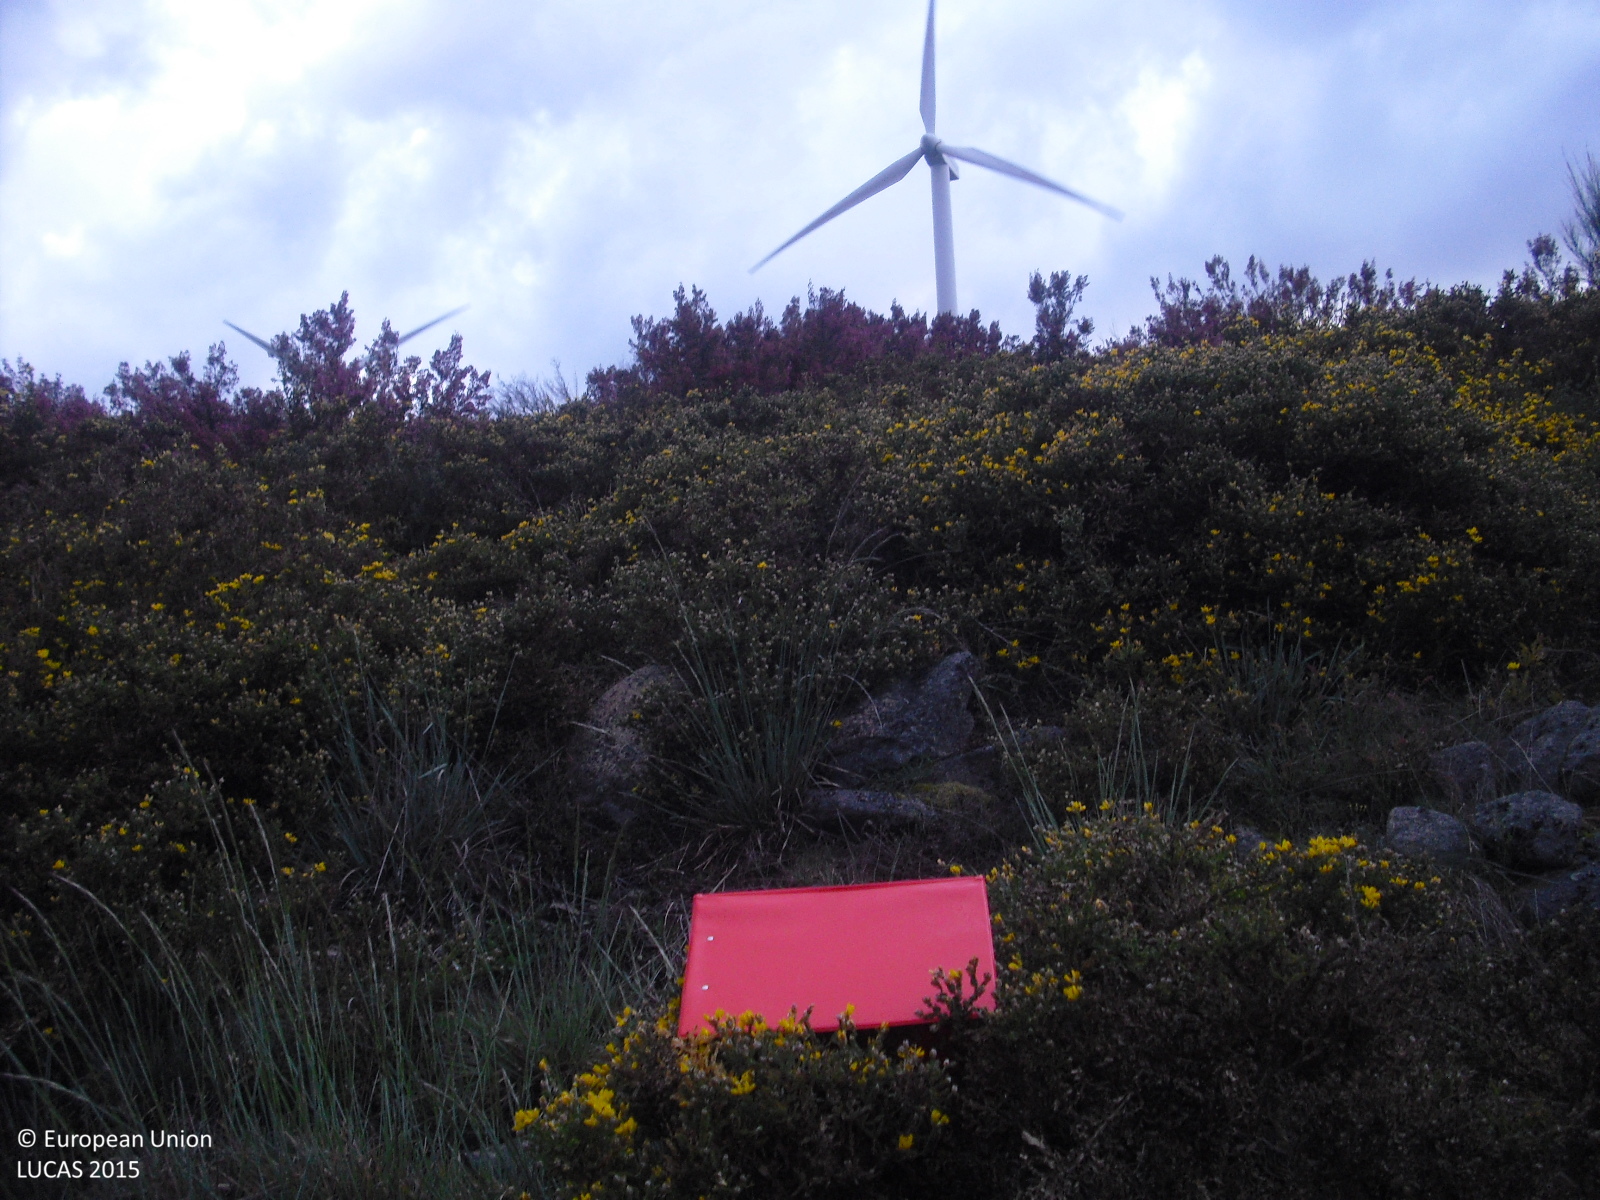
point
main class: Shrubland
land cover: Shrubland without tree cover
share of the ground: > 75 %
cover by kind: shrubs 70 %, herbaceous plants 15 %, consolidated bare surface 15 %
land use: Forestry
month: April
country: ES
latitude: 41.9357
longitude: -7.6624
